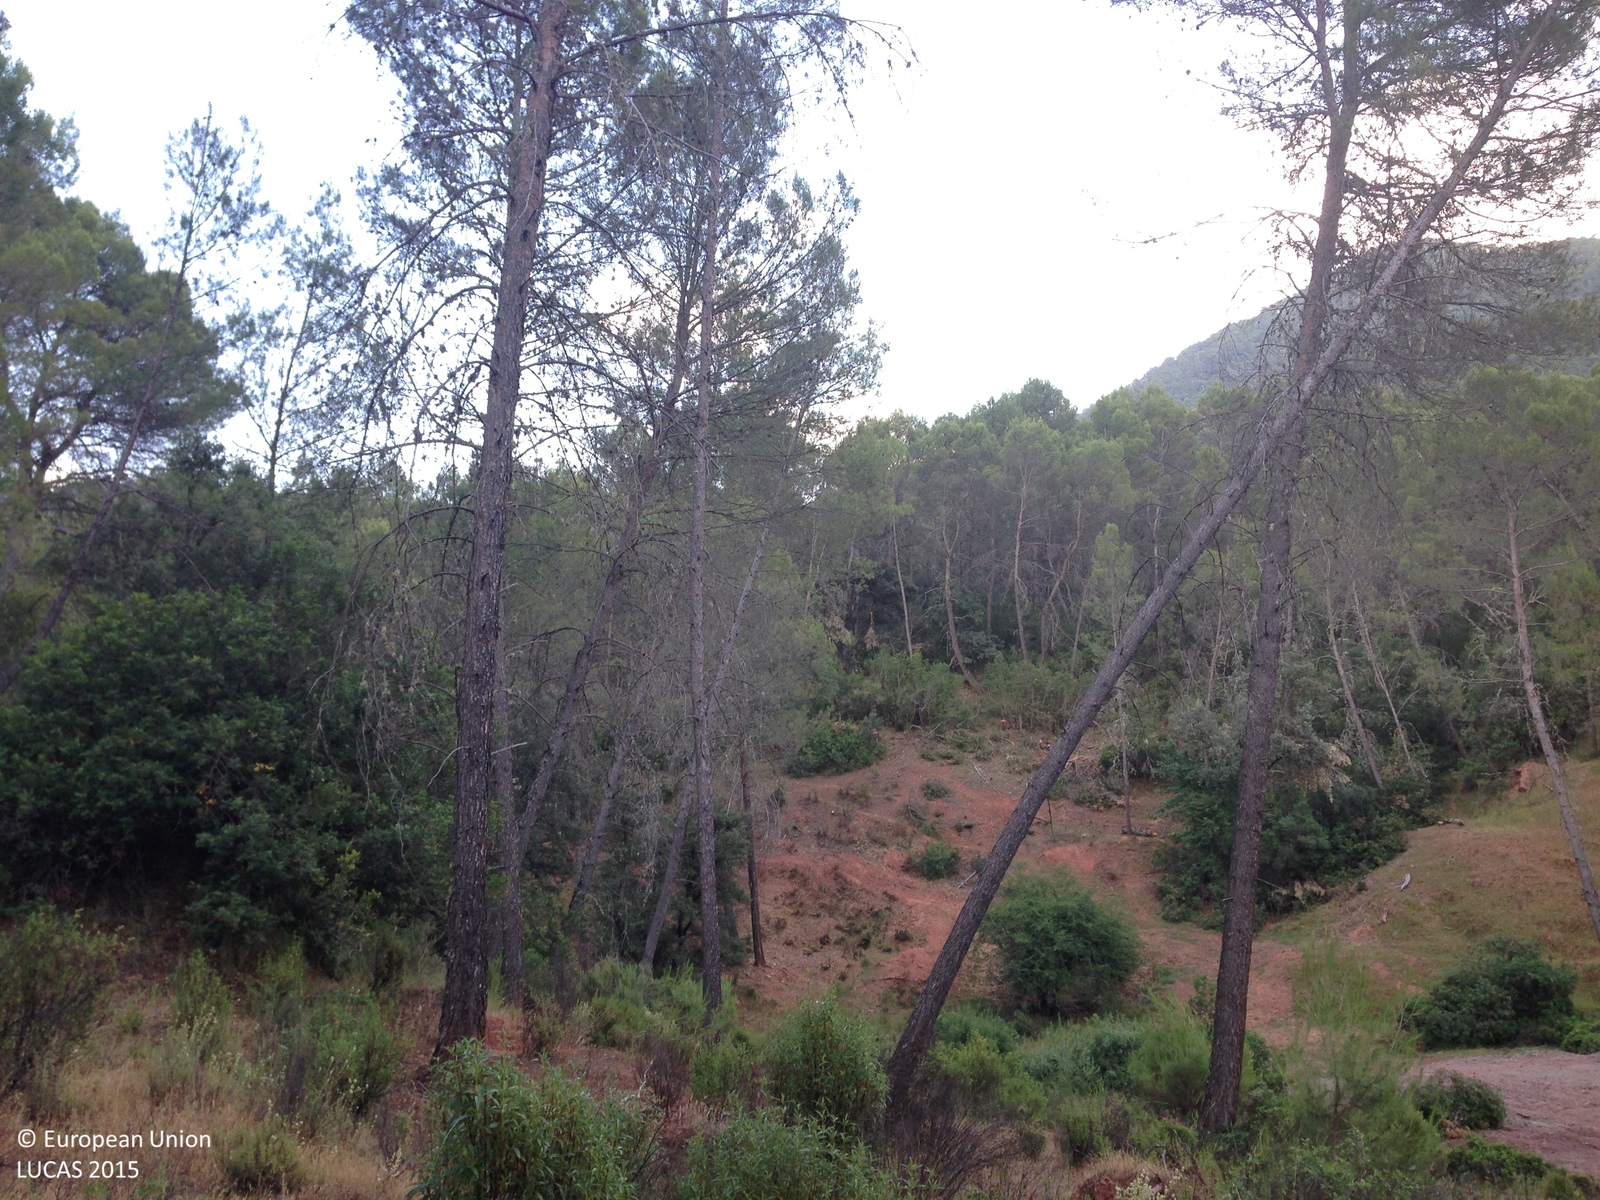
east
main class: Woodland
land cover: Pine dominated coniferous woodland
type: coniferous forest of the mediterranean region
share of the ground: > 75 %
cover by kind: coniferous forest trees 100 %
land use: Forestry
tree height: > 5 m
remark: Clear cut
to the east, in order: Pine dominated coniferous woodland
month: June
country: ES
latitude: 38.0468
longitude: -2.8380
